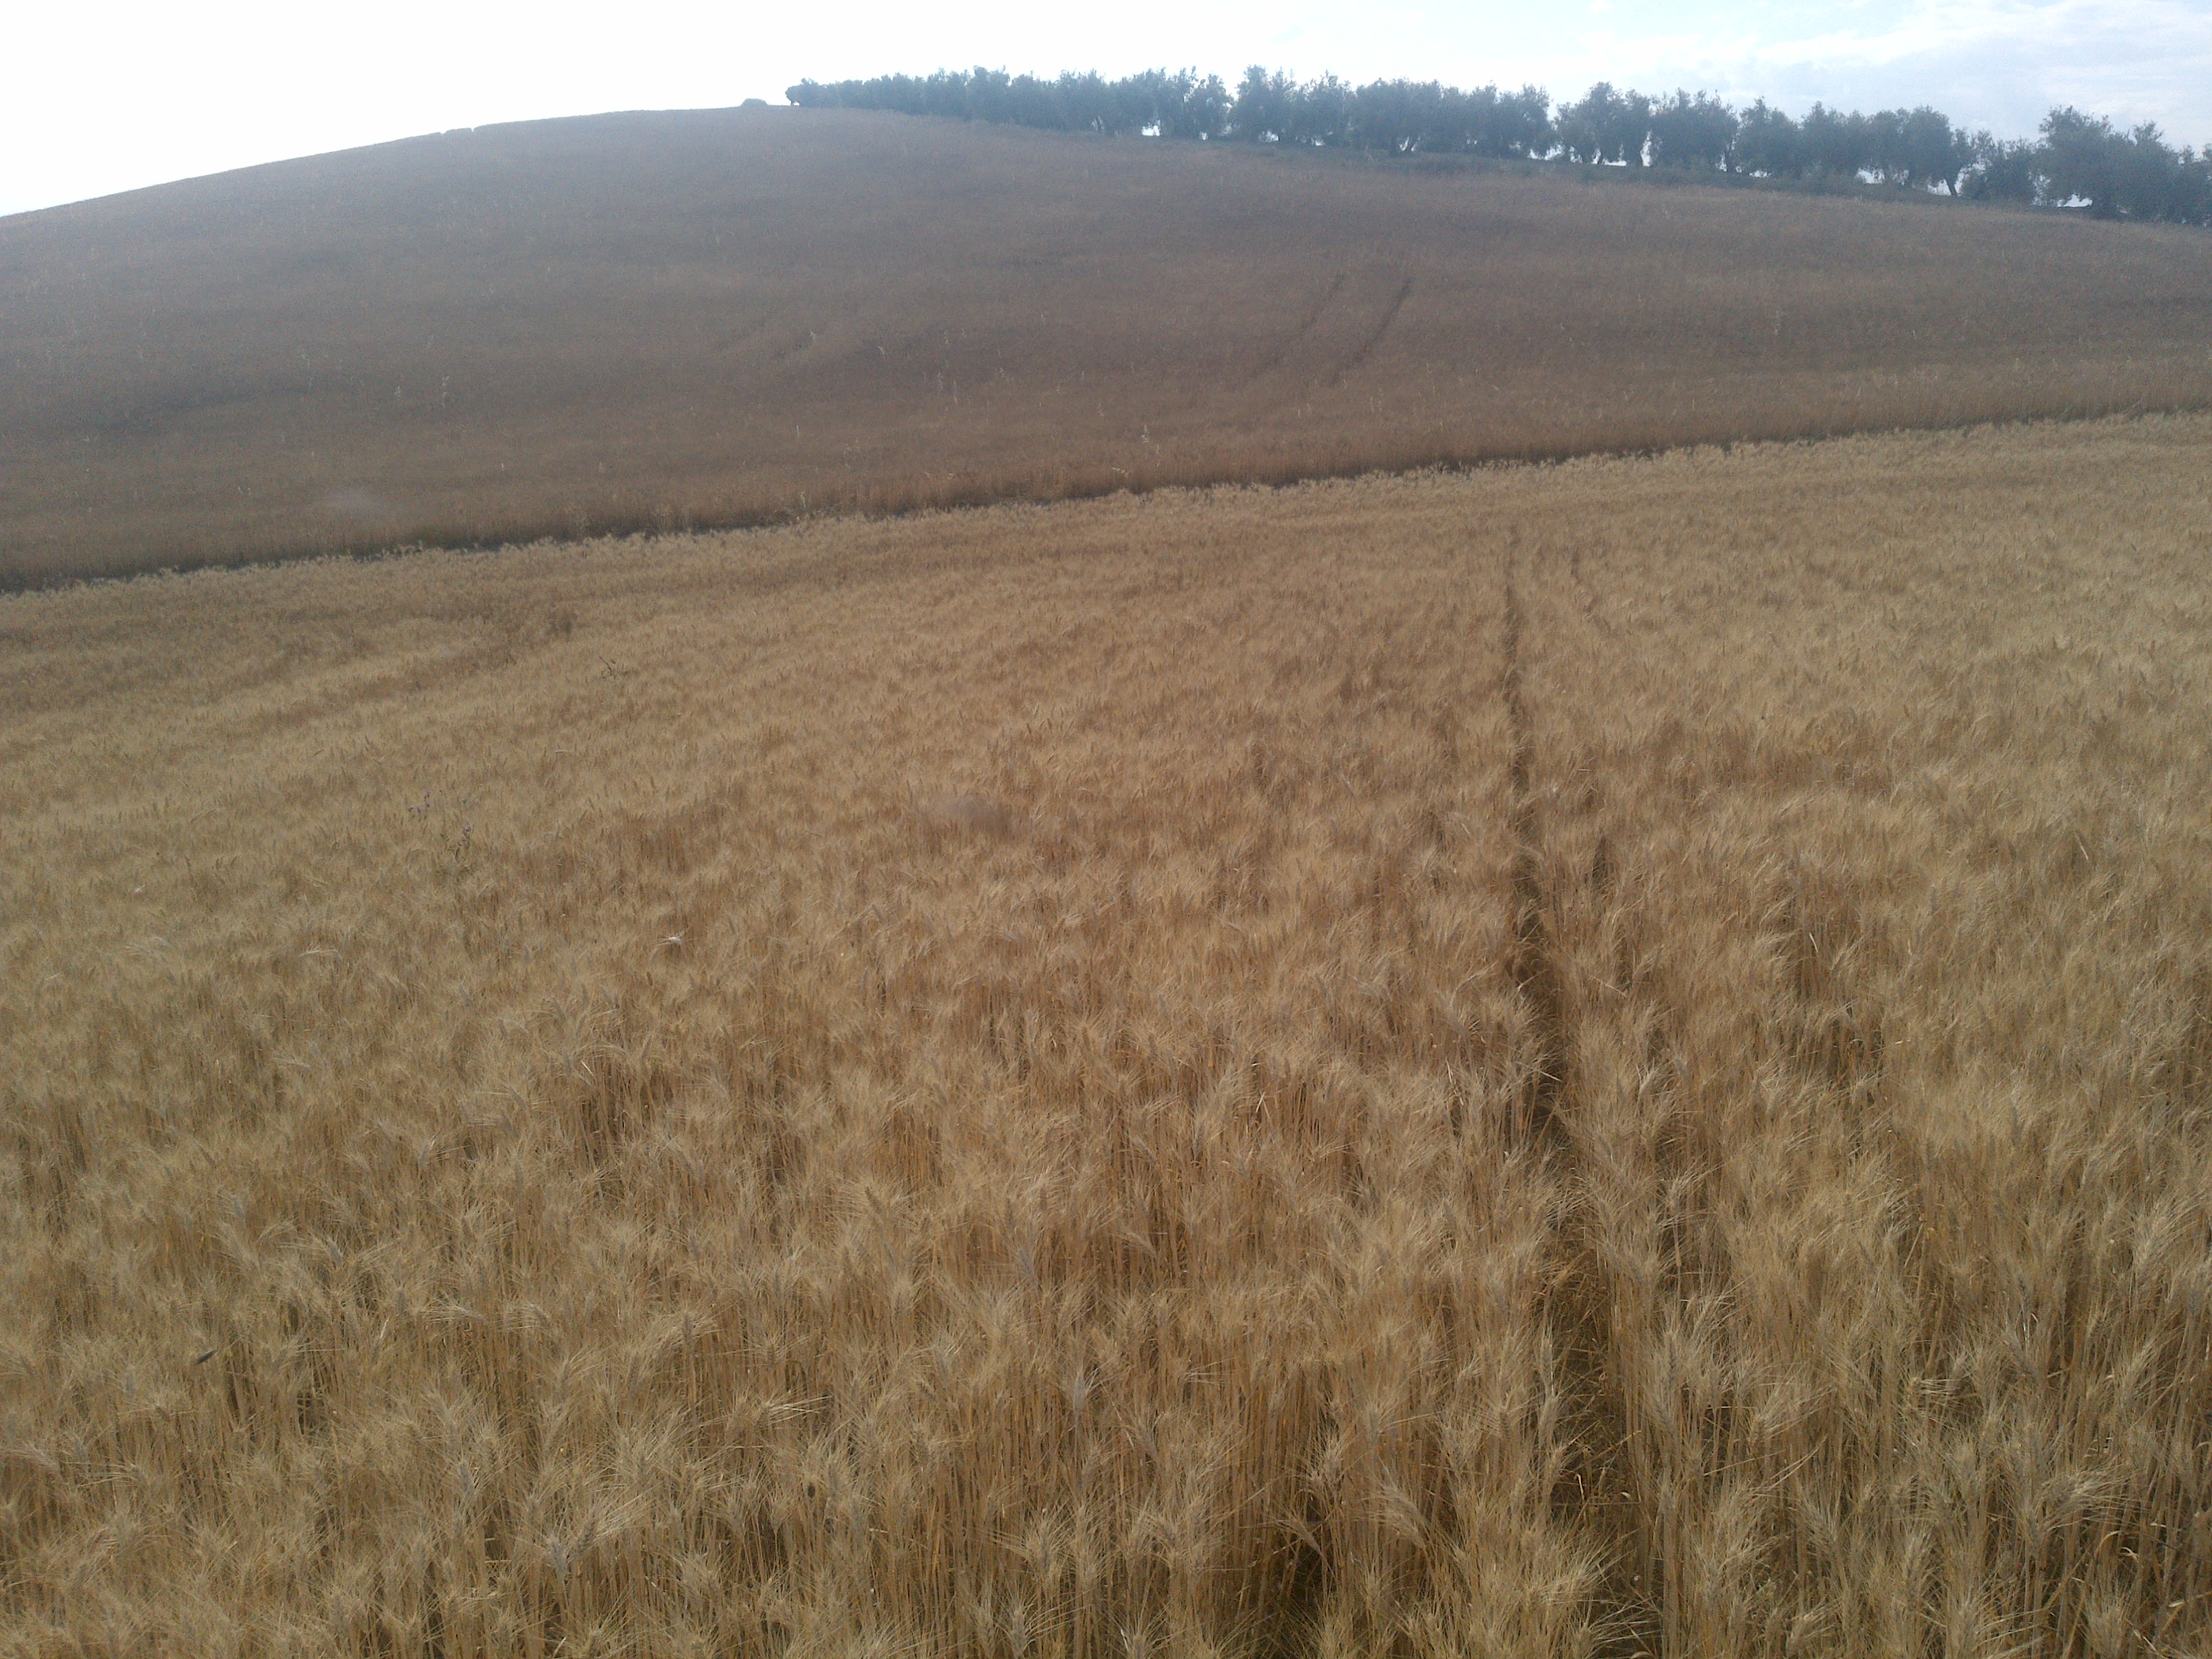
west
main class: Cropland
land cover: Durum wheat
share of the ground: > 75 %
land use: Agriculture (excluding fallow land and kitchen gardens)
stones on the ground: 10 - 25 %
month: May
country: ES
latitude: 37.7722
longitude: -4.4836
